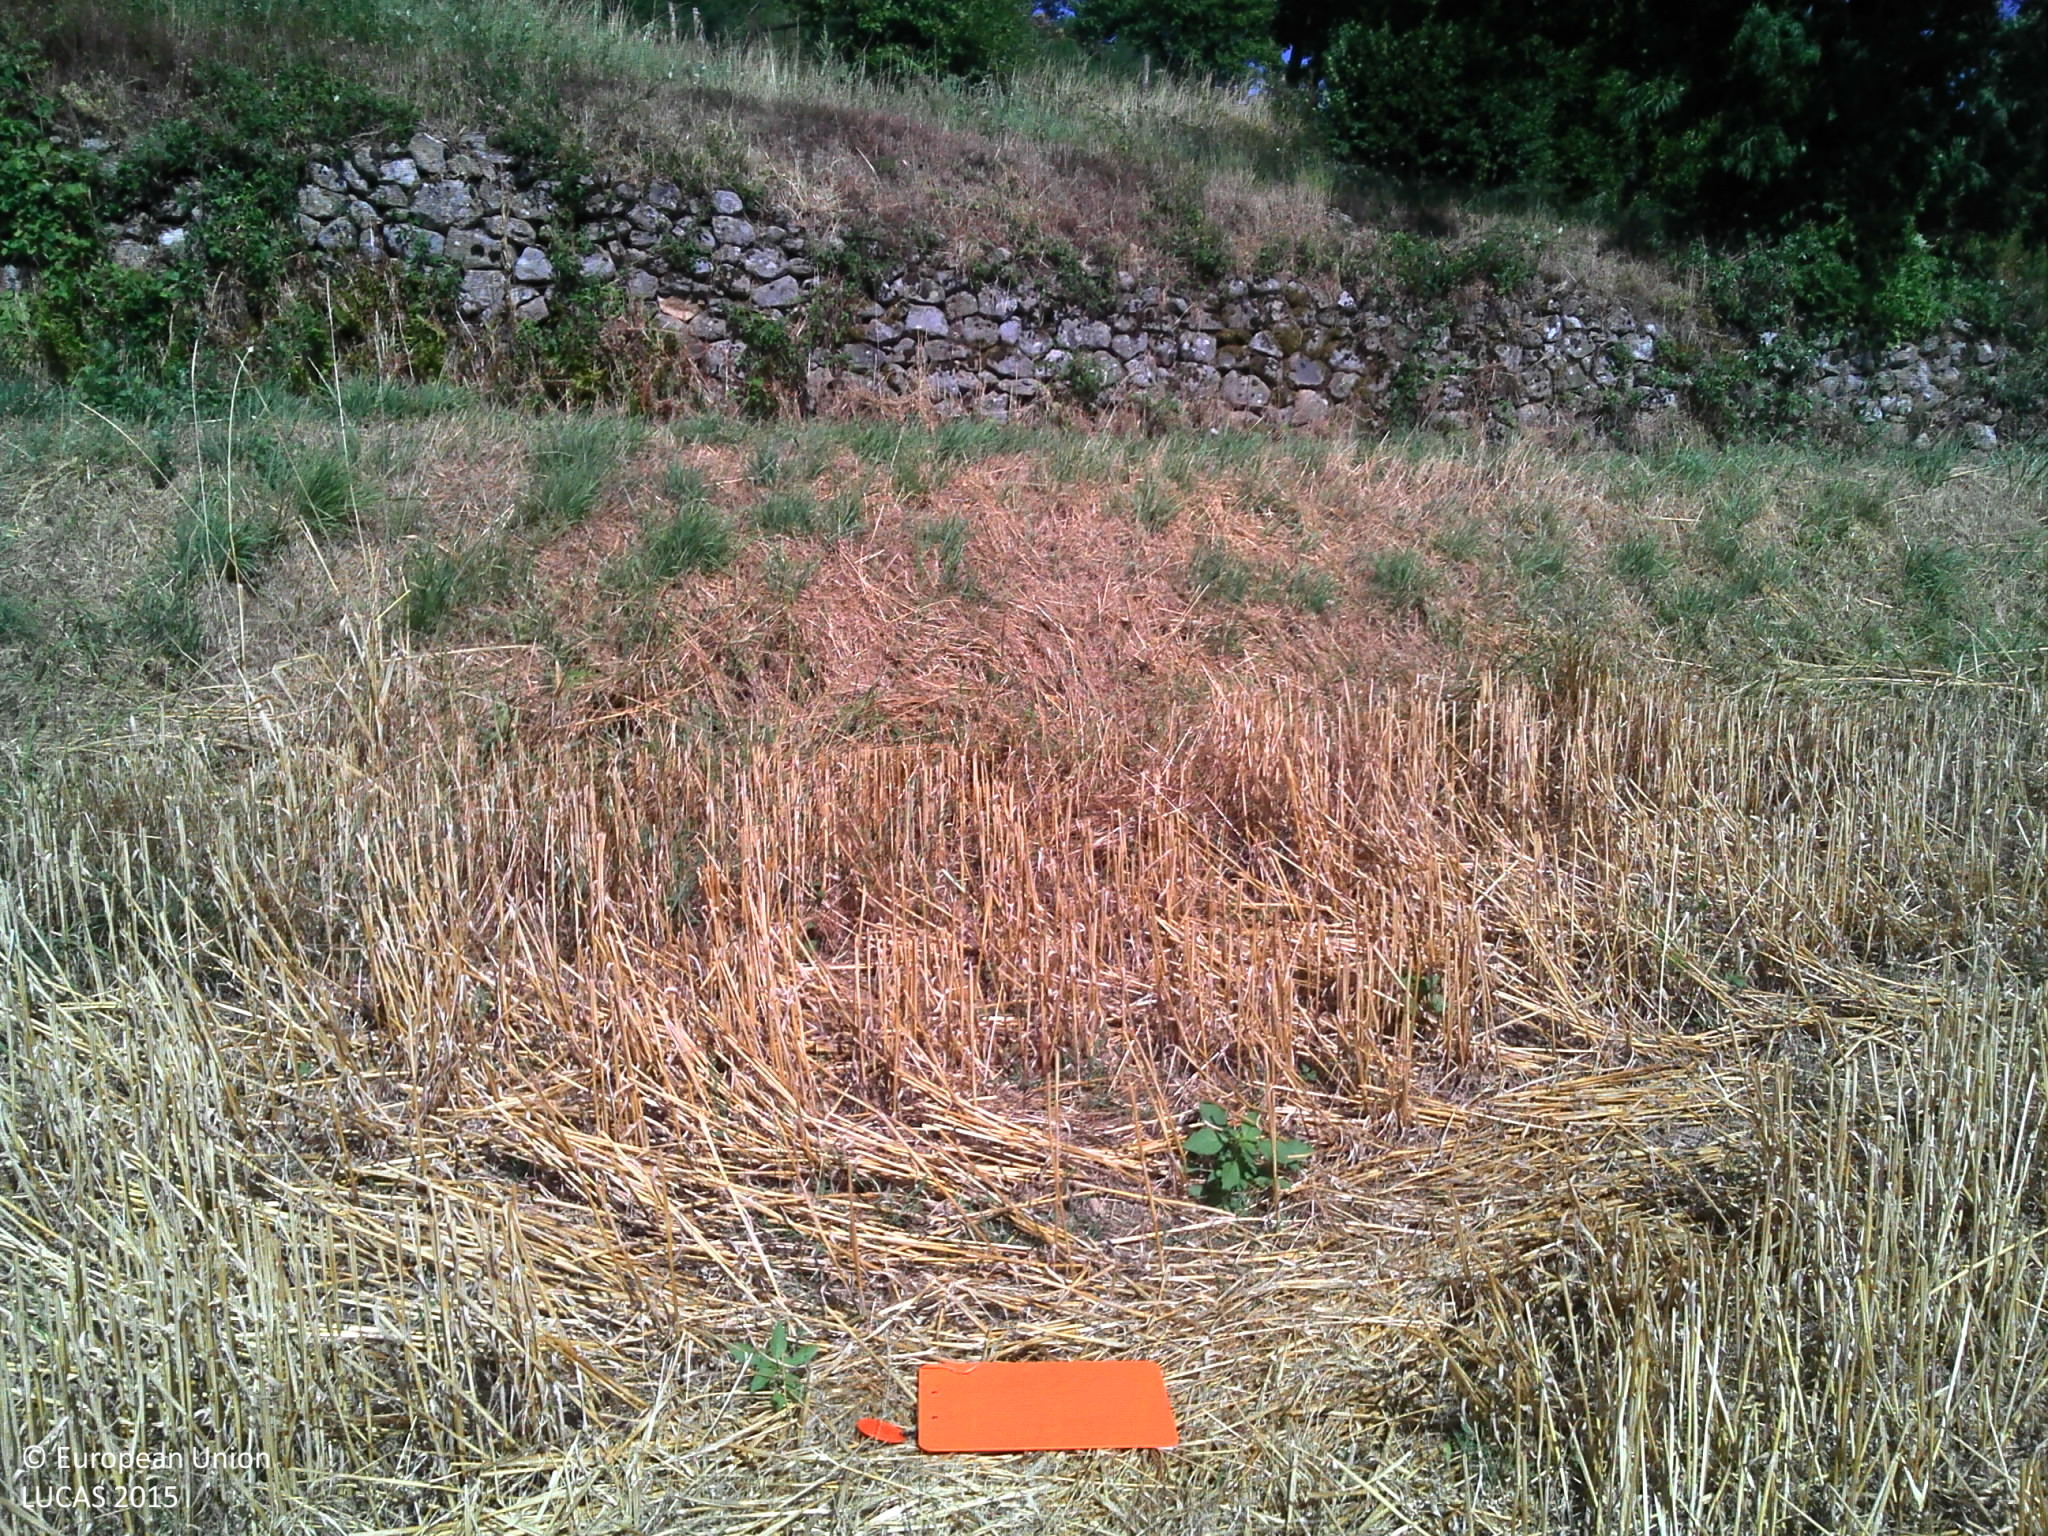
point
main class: Cropland
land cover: Barley
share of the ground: > 75 %
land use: Agriculture (excluding fallow land and kitchen gardens)
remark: Harvested field
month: July
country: FR
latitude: 44.9145
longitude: 4.5967
